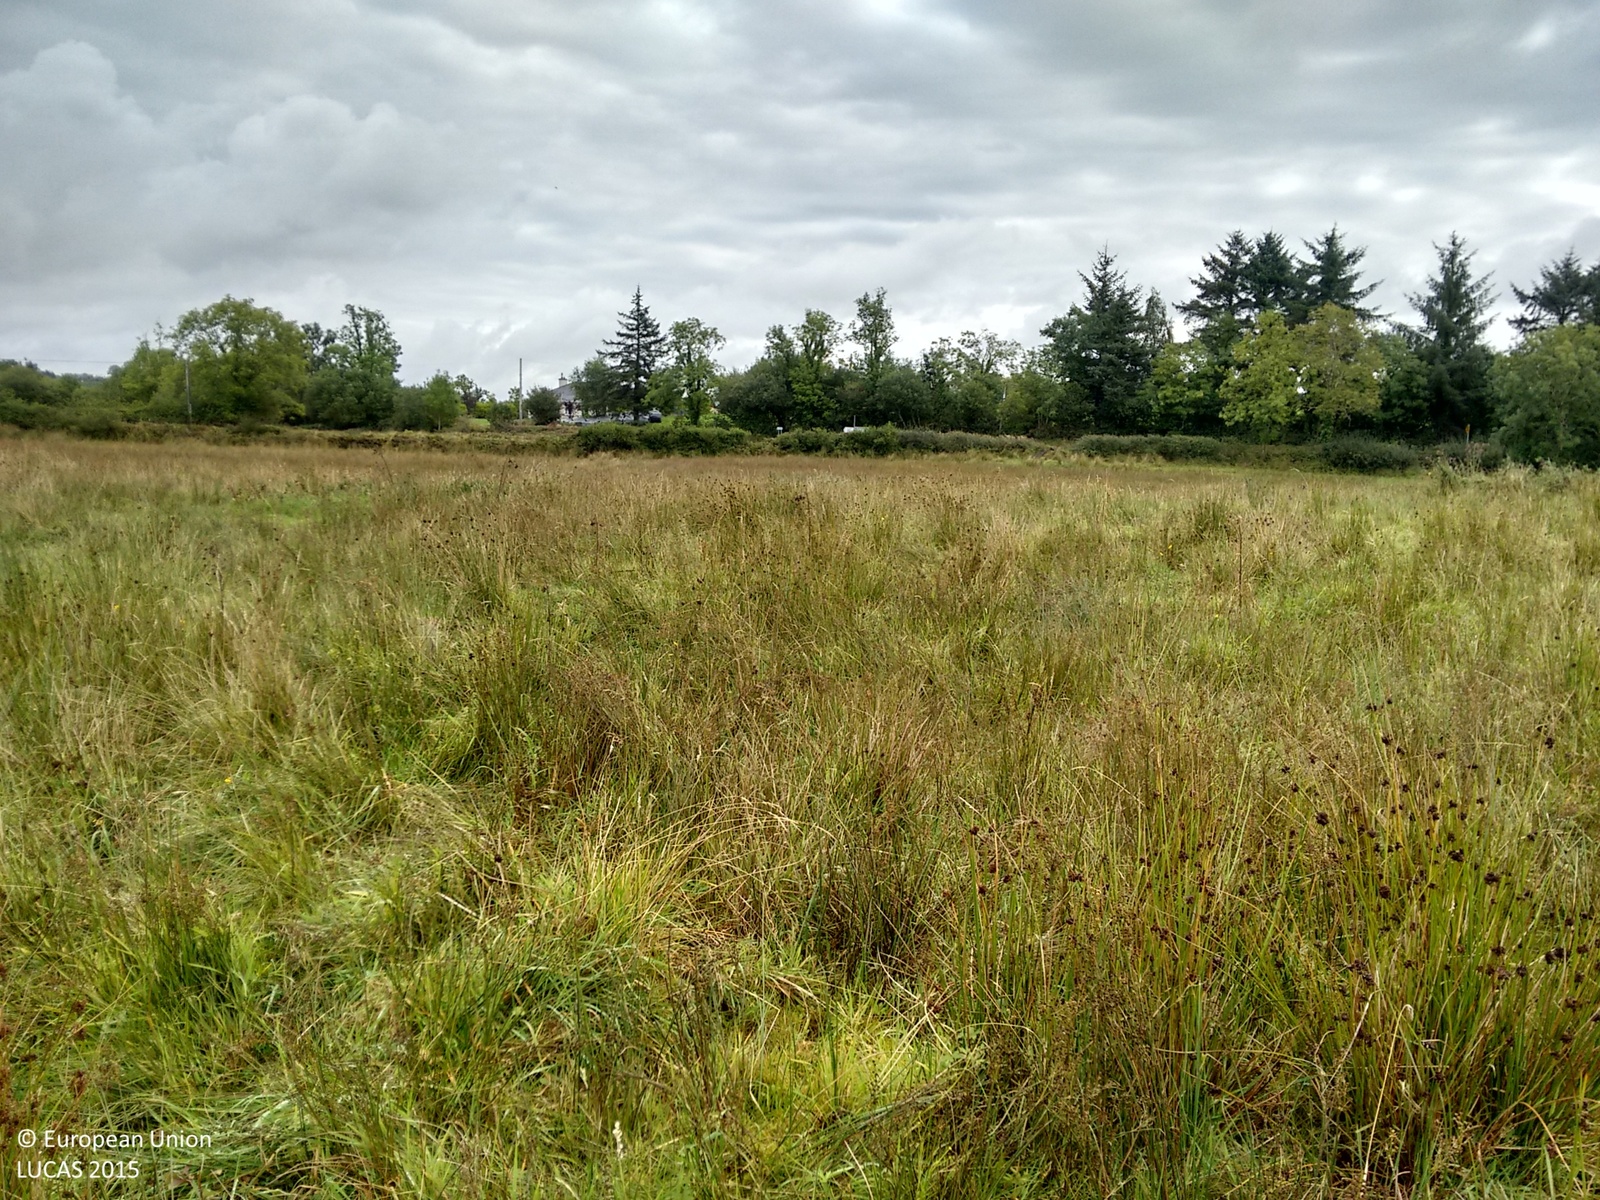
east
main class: Grassland
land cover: Grassland without tree/shrub cover
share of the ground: > 75 %
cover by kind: herbaceous plants 95 %
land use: Agriculture (excluding fallow land and kitchen gardens)
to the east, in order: Grassland without tree/shrub cover; Electric lines; Grassland without tree/shrub cover; Abandoned hedges; Dry stone walls; Managed hedges; Grass margins; Paved roads, cycling and walking lanes; Grass margins; Broadleaved woodland; Fences; Grassland without tree/shrub cover; Fences; Lines of trees; Artificial constructions in urban areas; Grassland without tree/shrub cover; Abandoned hedges
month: September
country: IE
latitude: 52.8943
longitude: -8.7695
